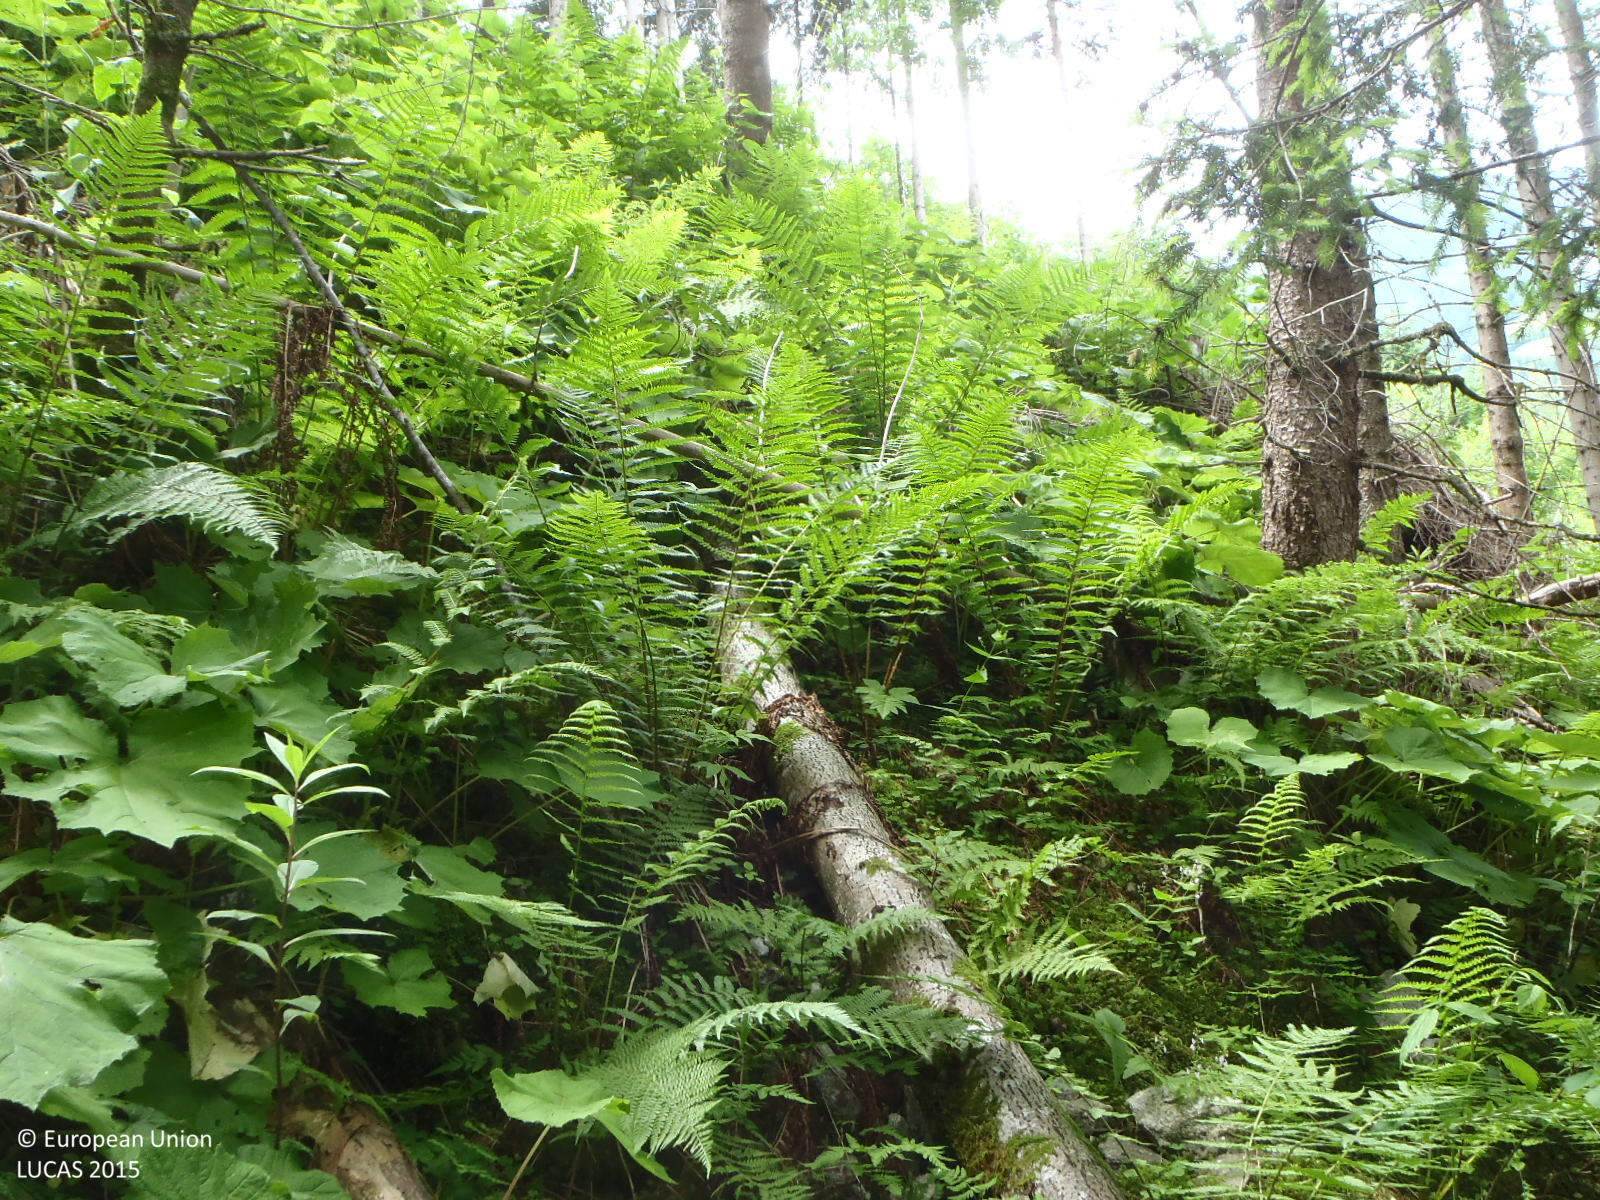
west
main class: Woodland
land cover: Spruce dominated coniferous woodland
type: alpine coniferous forest
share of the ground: > 75 %
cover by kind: coniferous forest trees 80 %, herbaceous plants 10 %, shrubs 5 %, lichens and mosses 5 %
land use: Forestry
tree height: > 5 m
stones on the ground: < 10 %
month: June
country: AT
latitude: 47.2229
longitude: 12.4940
